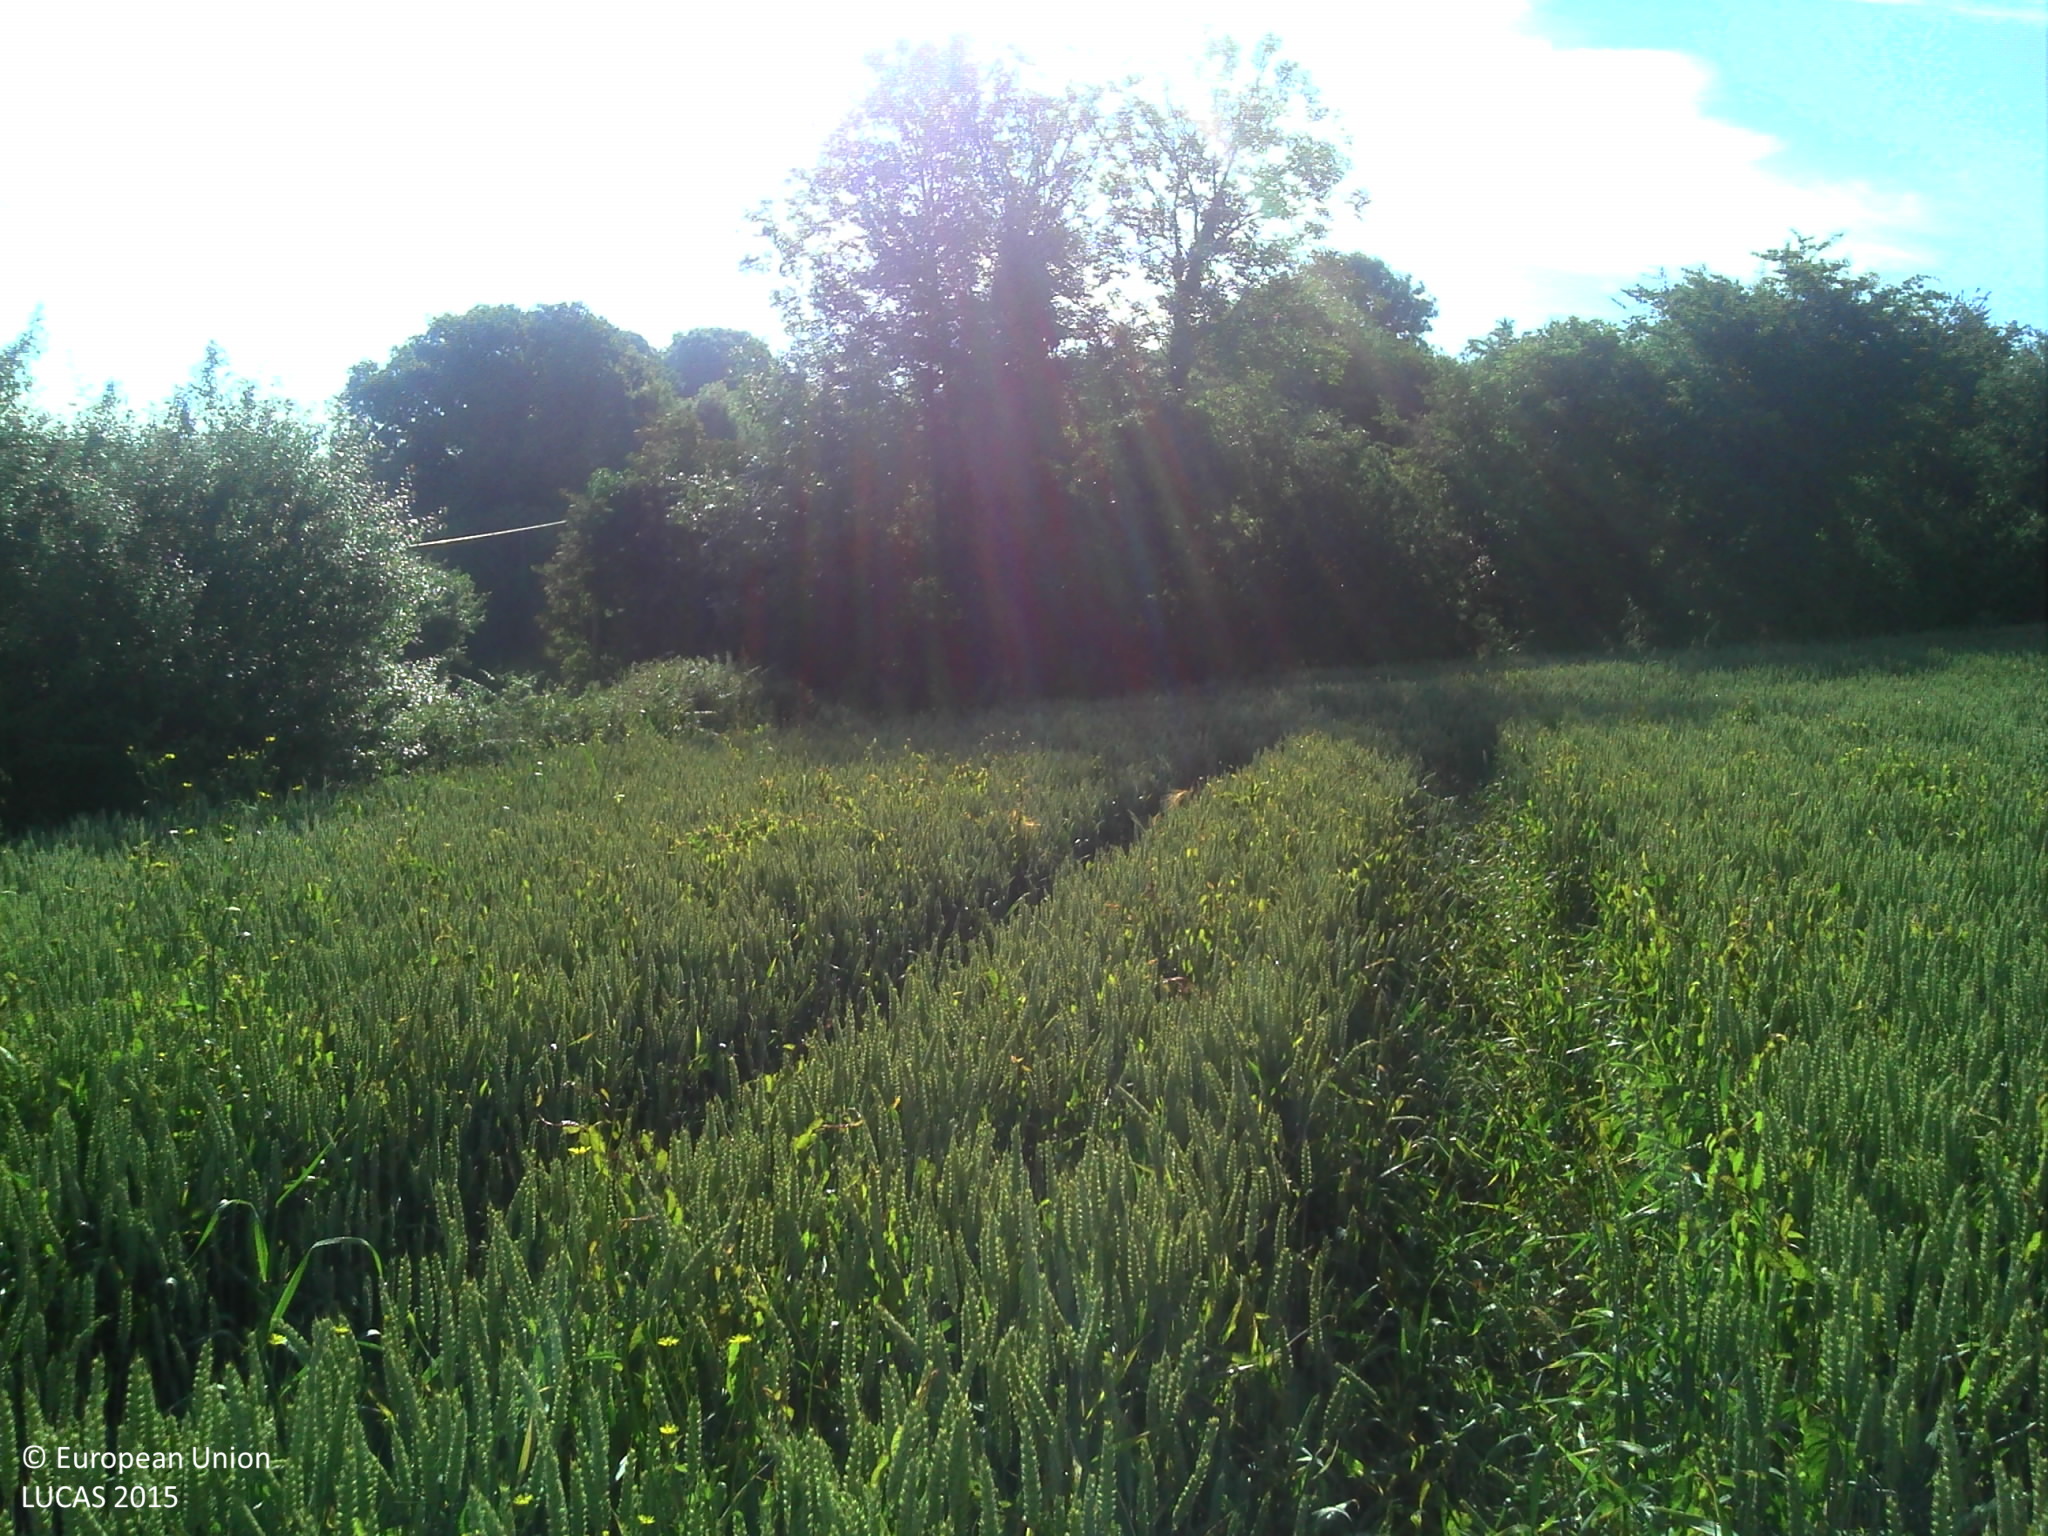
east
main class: Cropland
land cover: Common wheat
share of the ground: > 75 %
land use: Agriculture (excluding fallow land and kitchen gardens)
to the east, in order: Common wheat; Broadleaved woodland; Grassland without tree/shrub cover; Broadleaved woodland; Spontaneously vegetated surfaces; Broadleaved woodland; Maize; Broadleaved woodland; Grassland without tree/shrub cover; Abandoned hedges; Maize
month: June
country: FR
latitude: 49.3301
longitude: -1.6511
